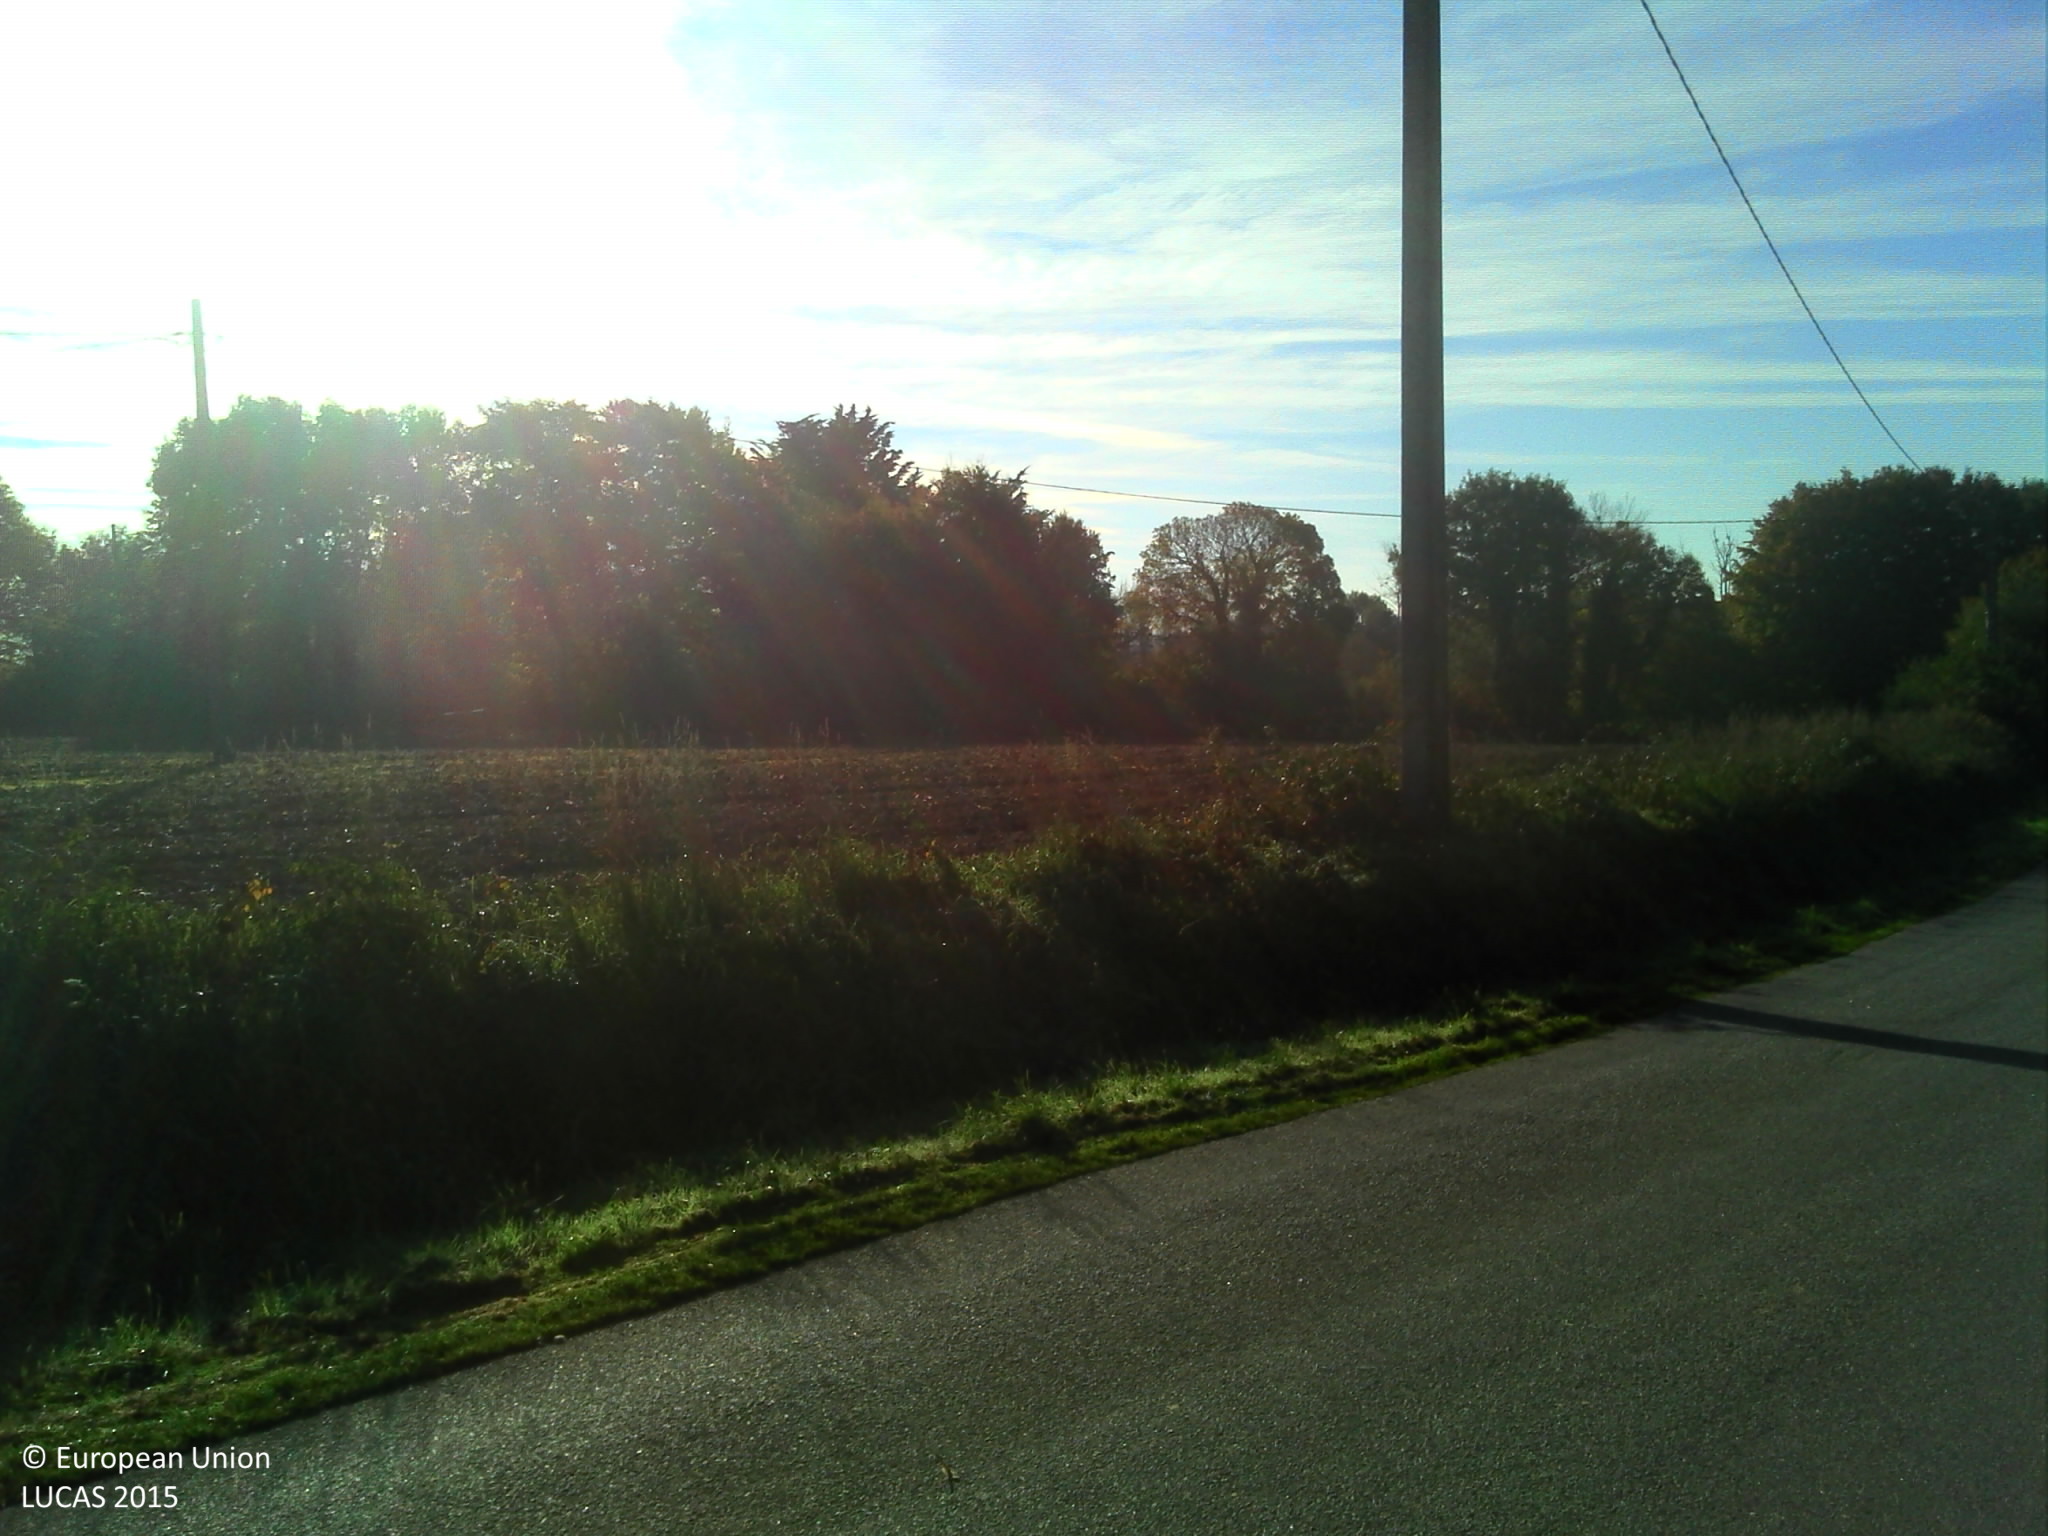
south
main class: Cropland
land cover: Maize
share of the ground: > 75 %
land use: Agriculture (excluding fallow land and kitchen gardens)
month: October
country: FR
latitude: 47.9643
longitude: -2.9648
